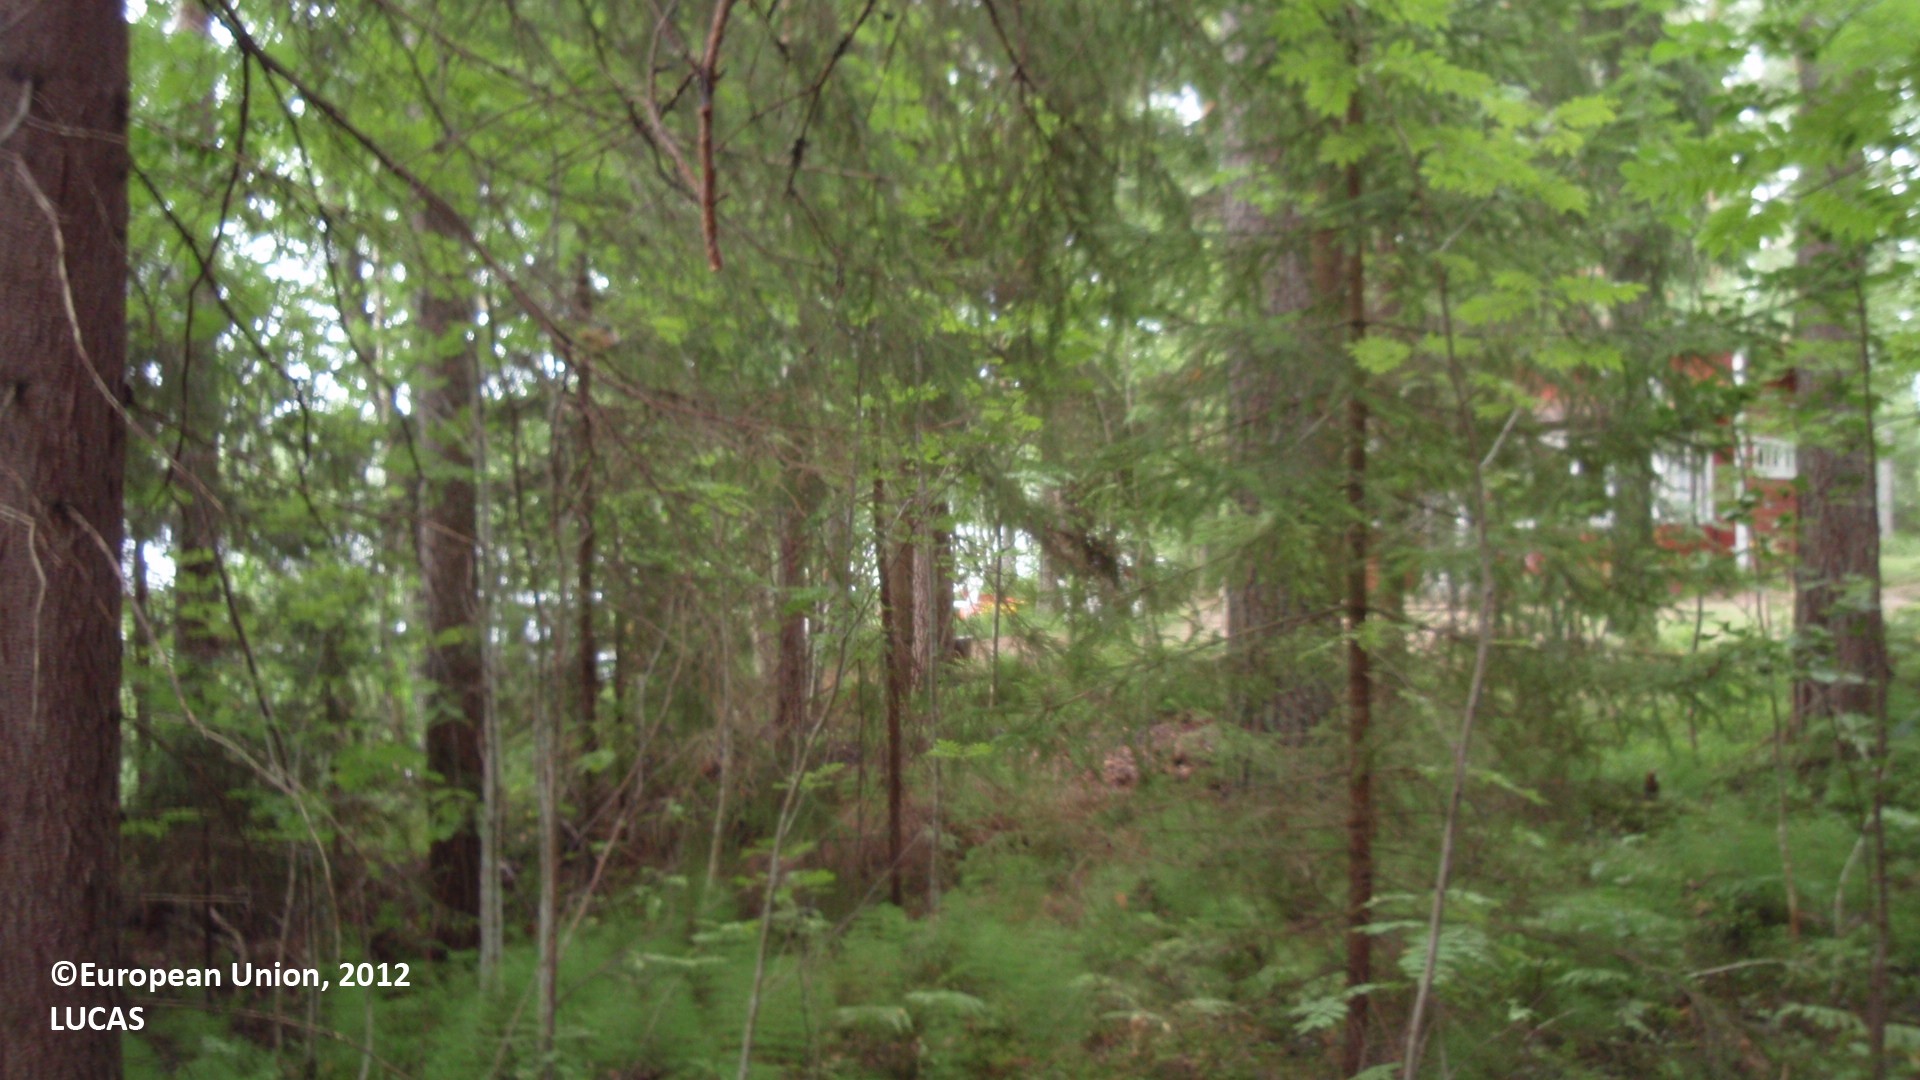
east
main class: Woodland
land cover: Other coniferous woodland
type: boreal forest
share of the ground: 50 - 75 %
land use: Forestry
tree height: > 5 m
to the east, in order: Other coniferous woodland; Inland marshes; Inland water bodies
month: August
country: FI
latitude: 60.9591
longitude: 26.9140
